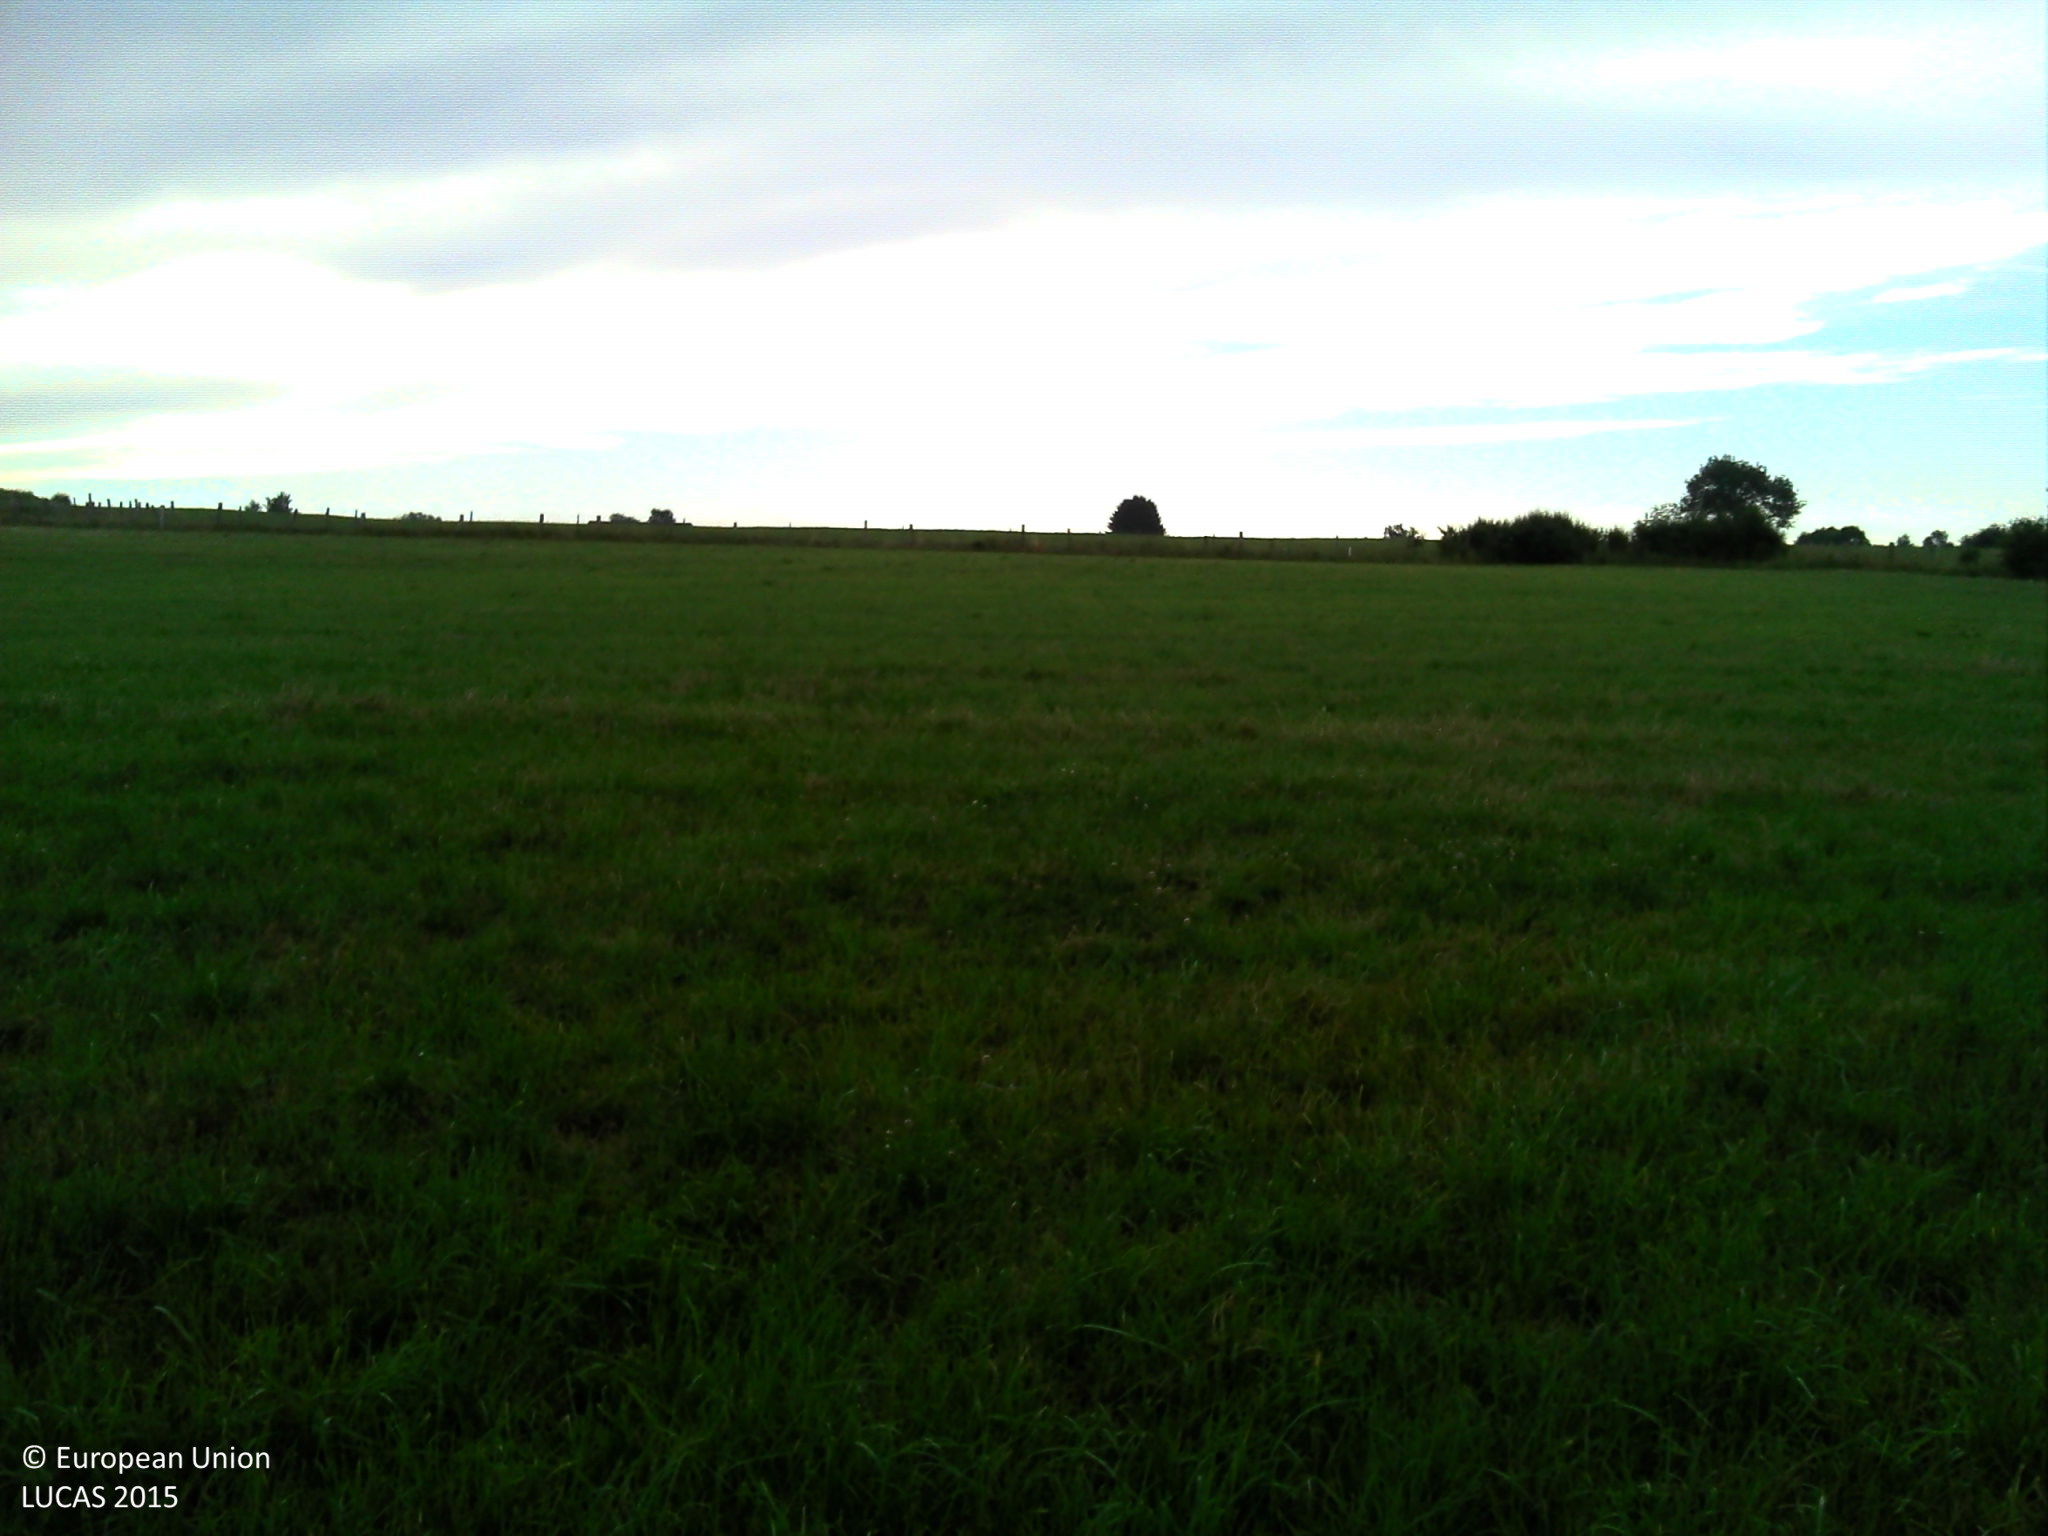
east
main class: Grassland
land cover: Grassland without tree/shrub cover
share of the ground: > 75 %
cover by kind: herbaceous plants 100 %
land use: Agriculture (excluding fallow land and kitchen gardens)
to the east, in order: Grassland without tree/shrub cover; Fences; Grass margins; Fences; Grassland without tree/shrub cover
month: July
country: BE
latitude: 49.6885
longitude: 5.6878
